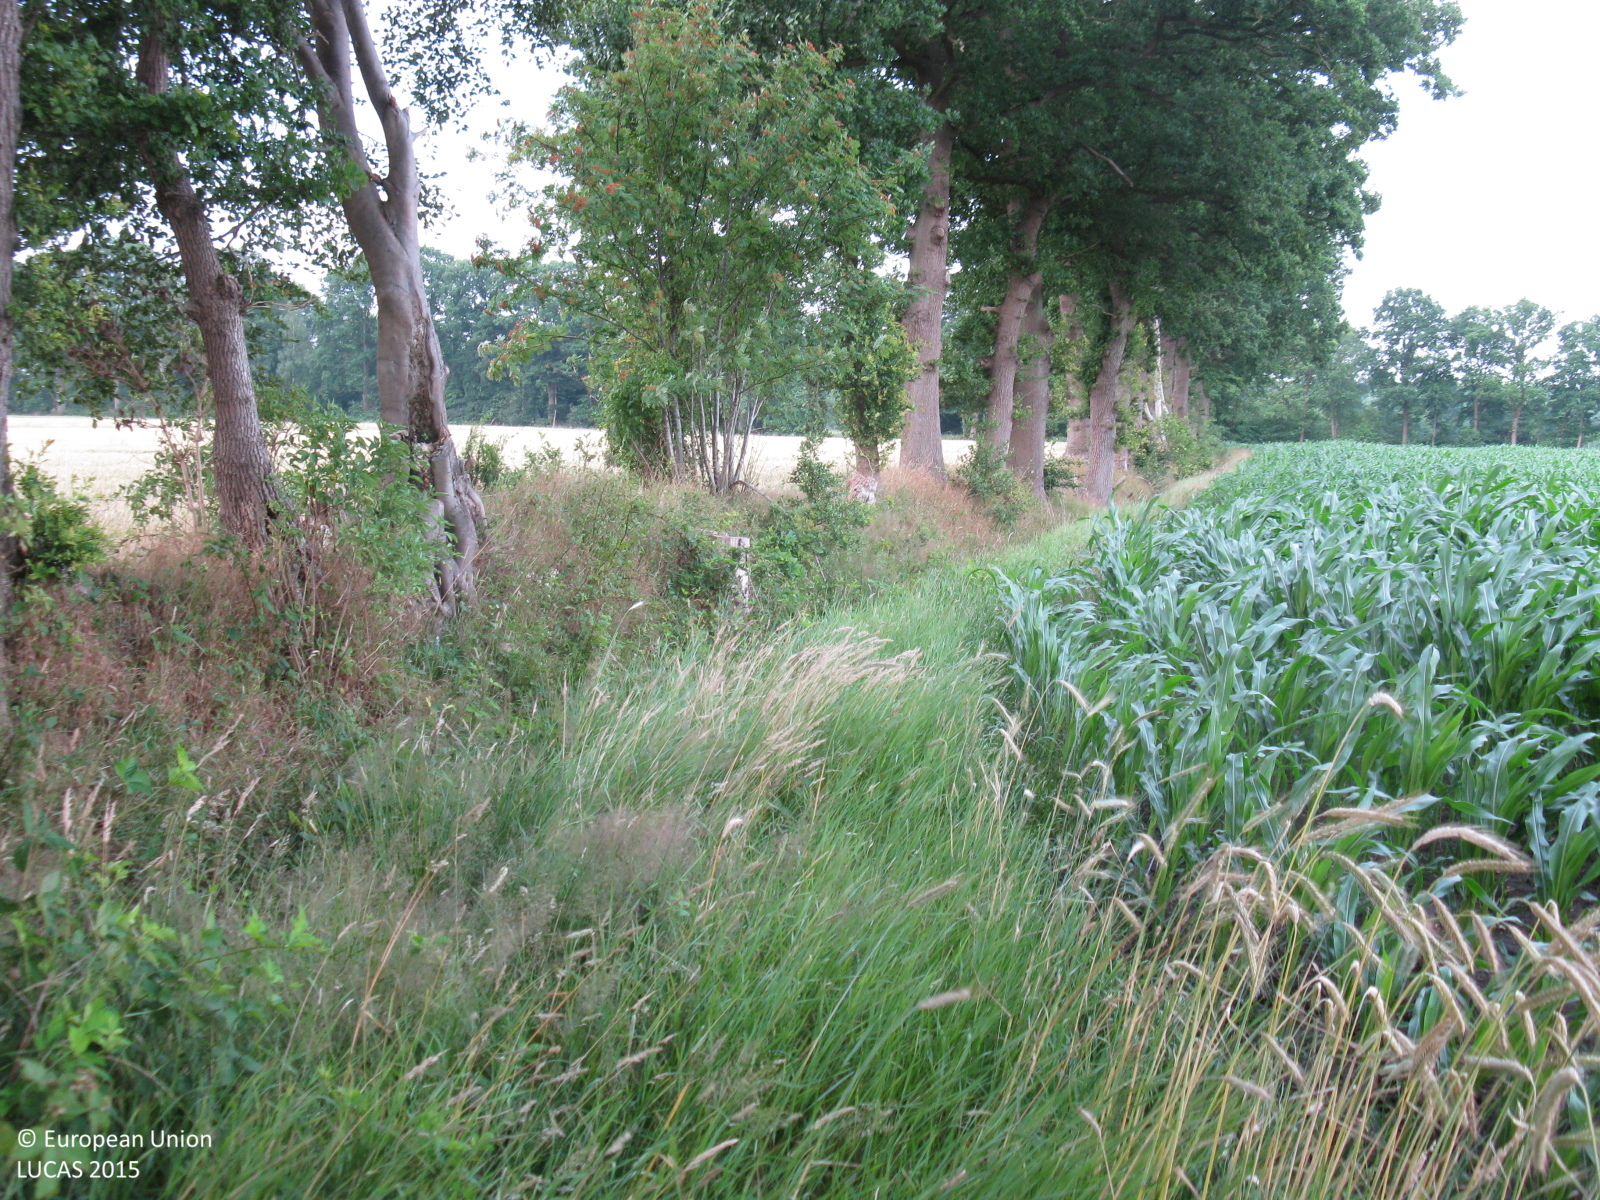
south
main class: Cropland
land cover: Maize
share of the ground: > 75 %
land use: Agriculture (excluding fallow land and kitchen gardens)
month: July
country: DE
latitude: 53.2412
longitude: 7.9778
